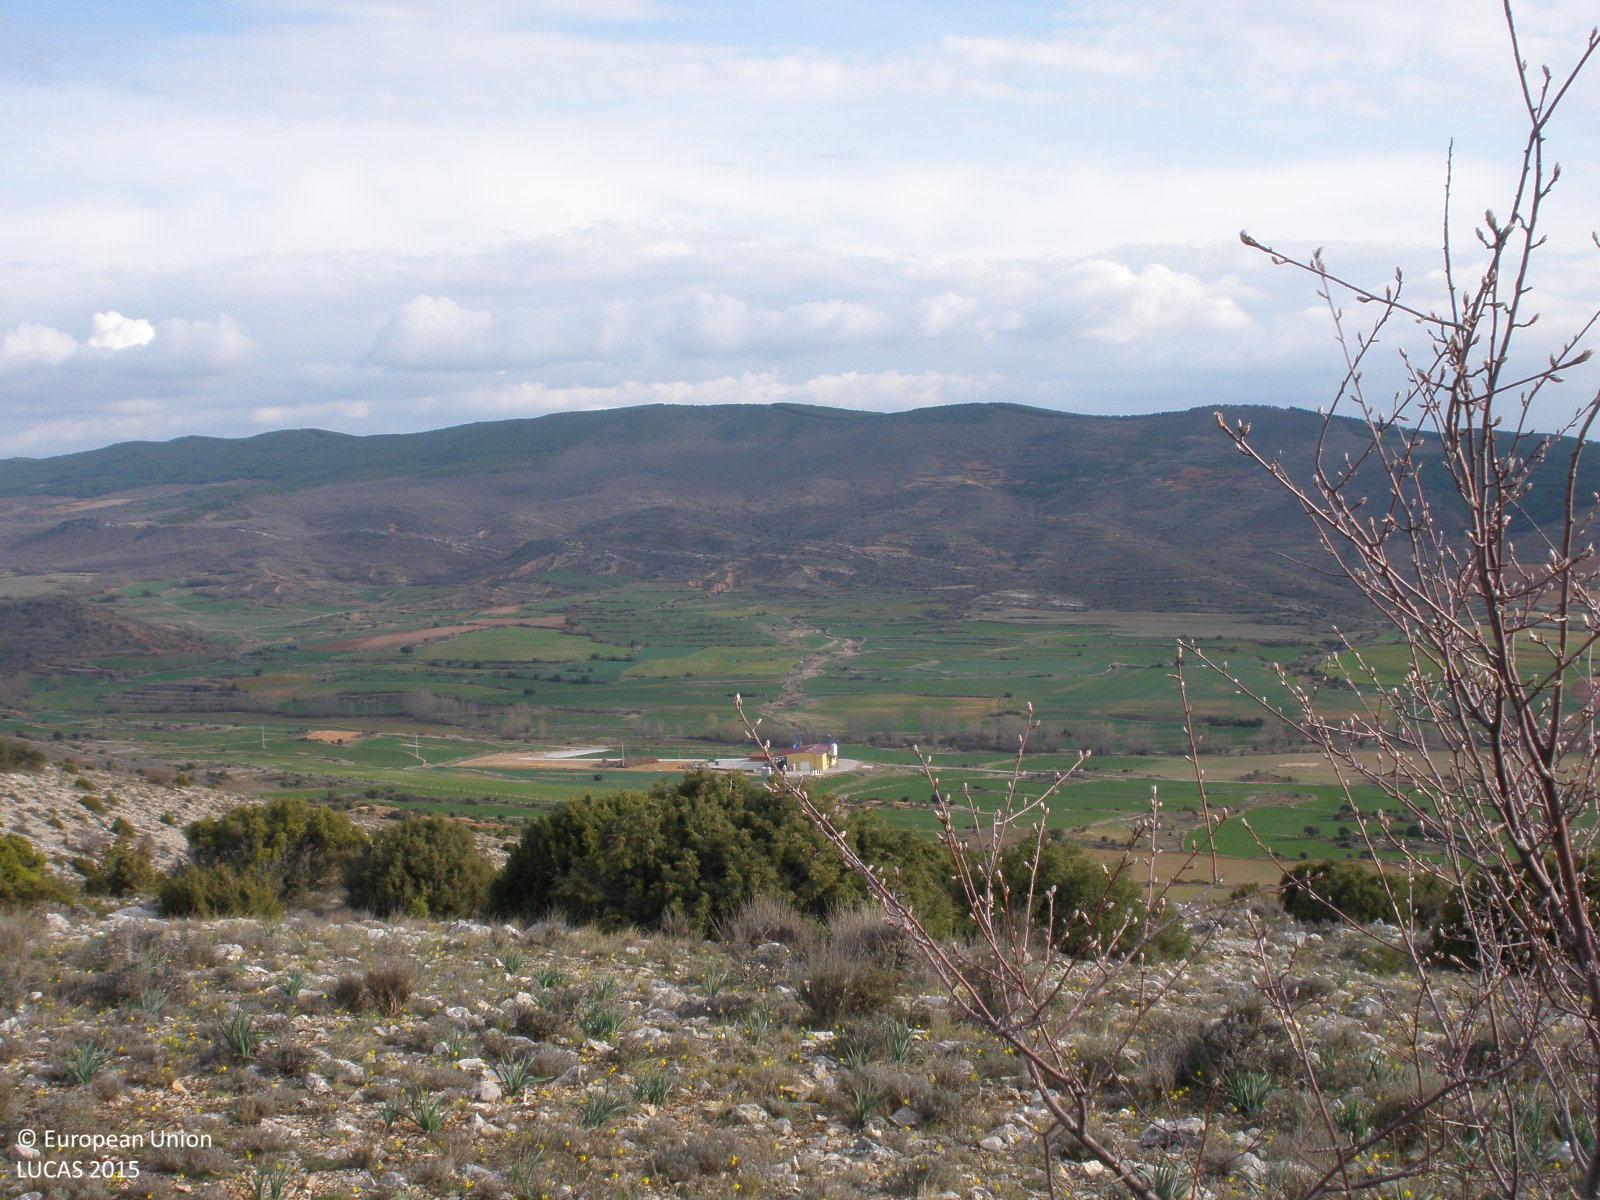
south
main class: Woodland
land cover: Other coniferous woodland
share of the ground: 10 - 25 %
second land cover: Grassland without tree/shrub cover
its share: 10 - 25 %
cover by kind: shrubs 30 %, herbaceous plants 30 %, coniferous forest trees 20 %, consolidated bare surface 10 %, unconsolidated bare surface 10 %
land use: Forestry
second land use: Agriculture (excluding fallow land and kitchen gardens)
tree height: < 5 m
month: April
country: ES
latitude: 41.0506
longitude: -1.1663
